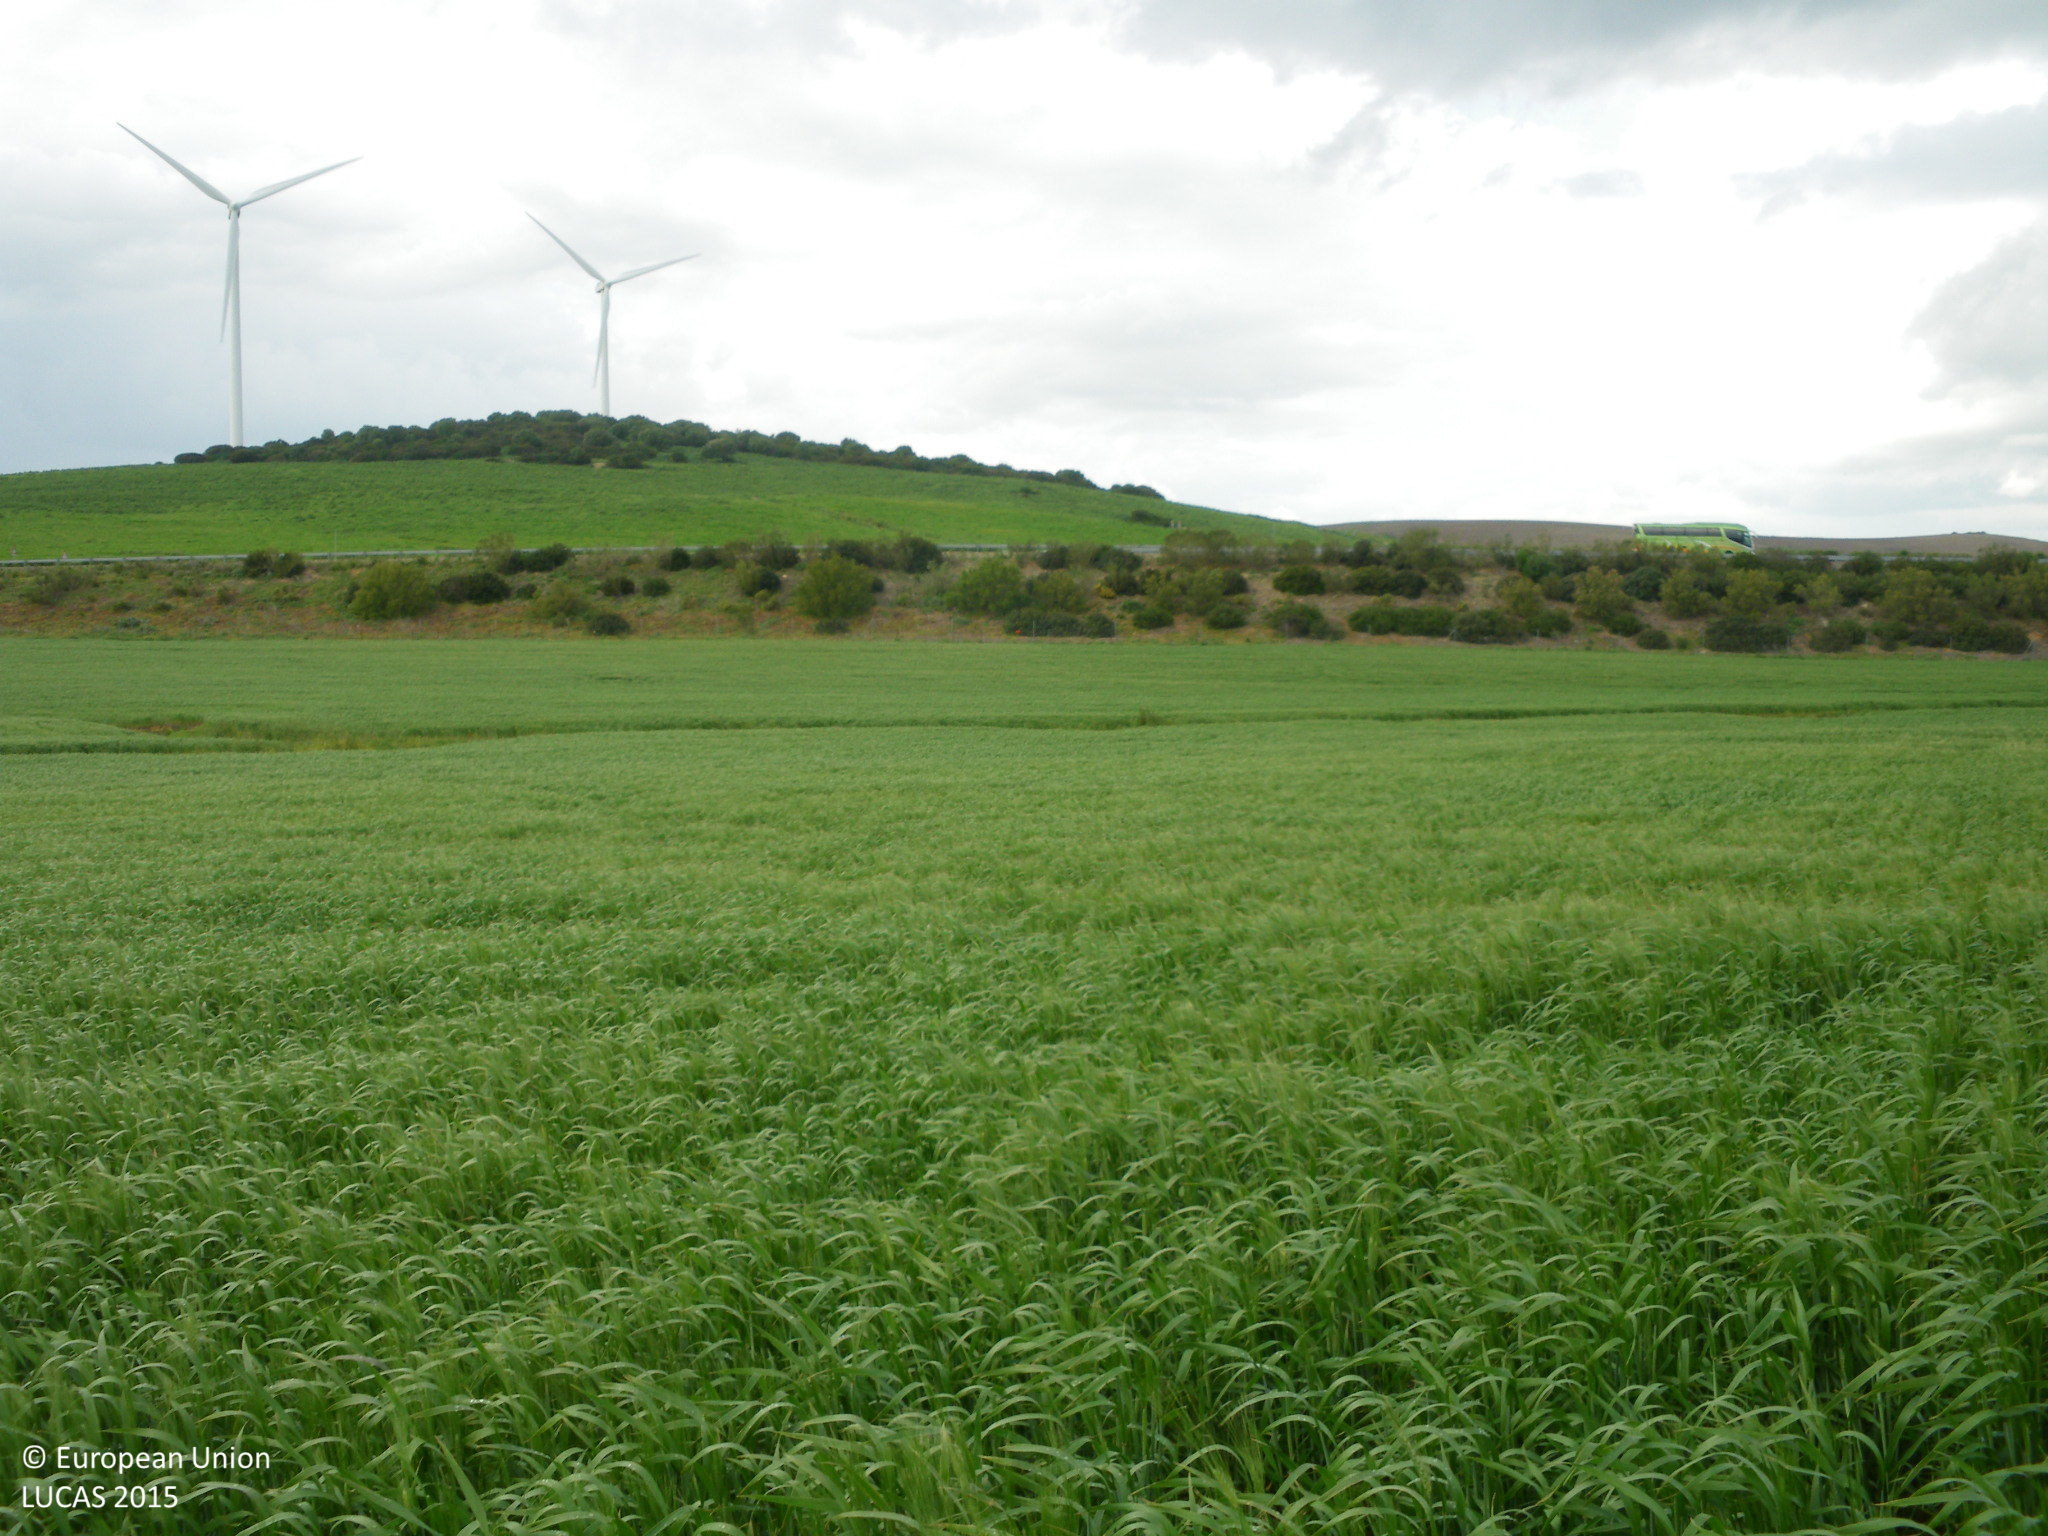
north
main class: Cropland
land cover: Durum wheat
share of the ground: > 75 %
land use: Agriculture (excluding fallow land and kitchen gardens)
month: April
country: ES
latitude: 36.4766
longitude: -5.8863
